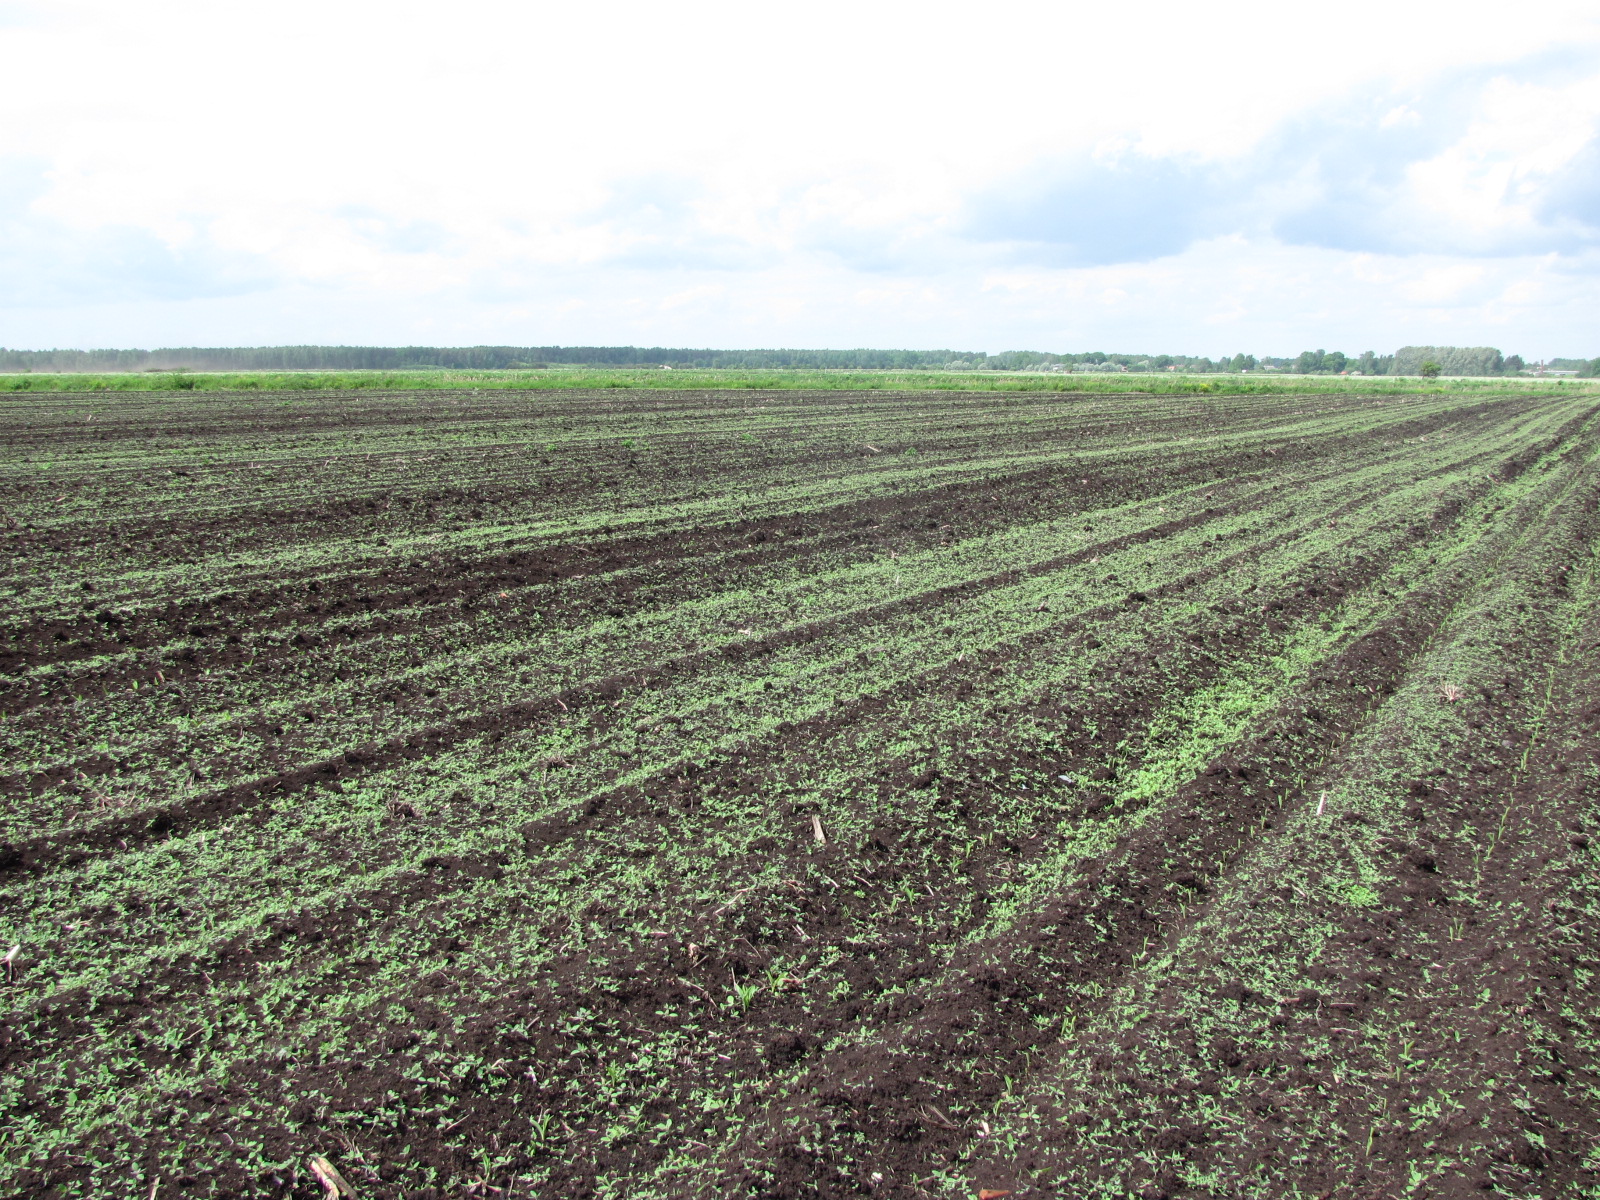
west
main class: Cropland
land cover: Maize
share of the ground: < 10 %
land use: Agriculture (excluding fallow land and kitchen gardens)
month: June
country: LV
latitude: 56.8622
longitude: 23.9755
